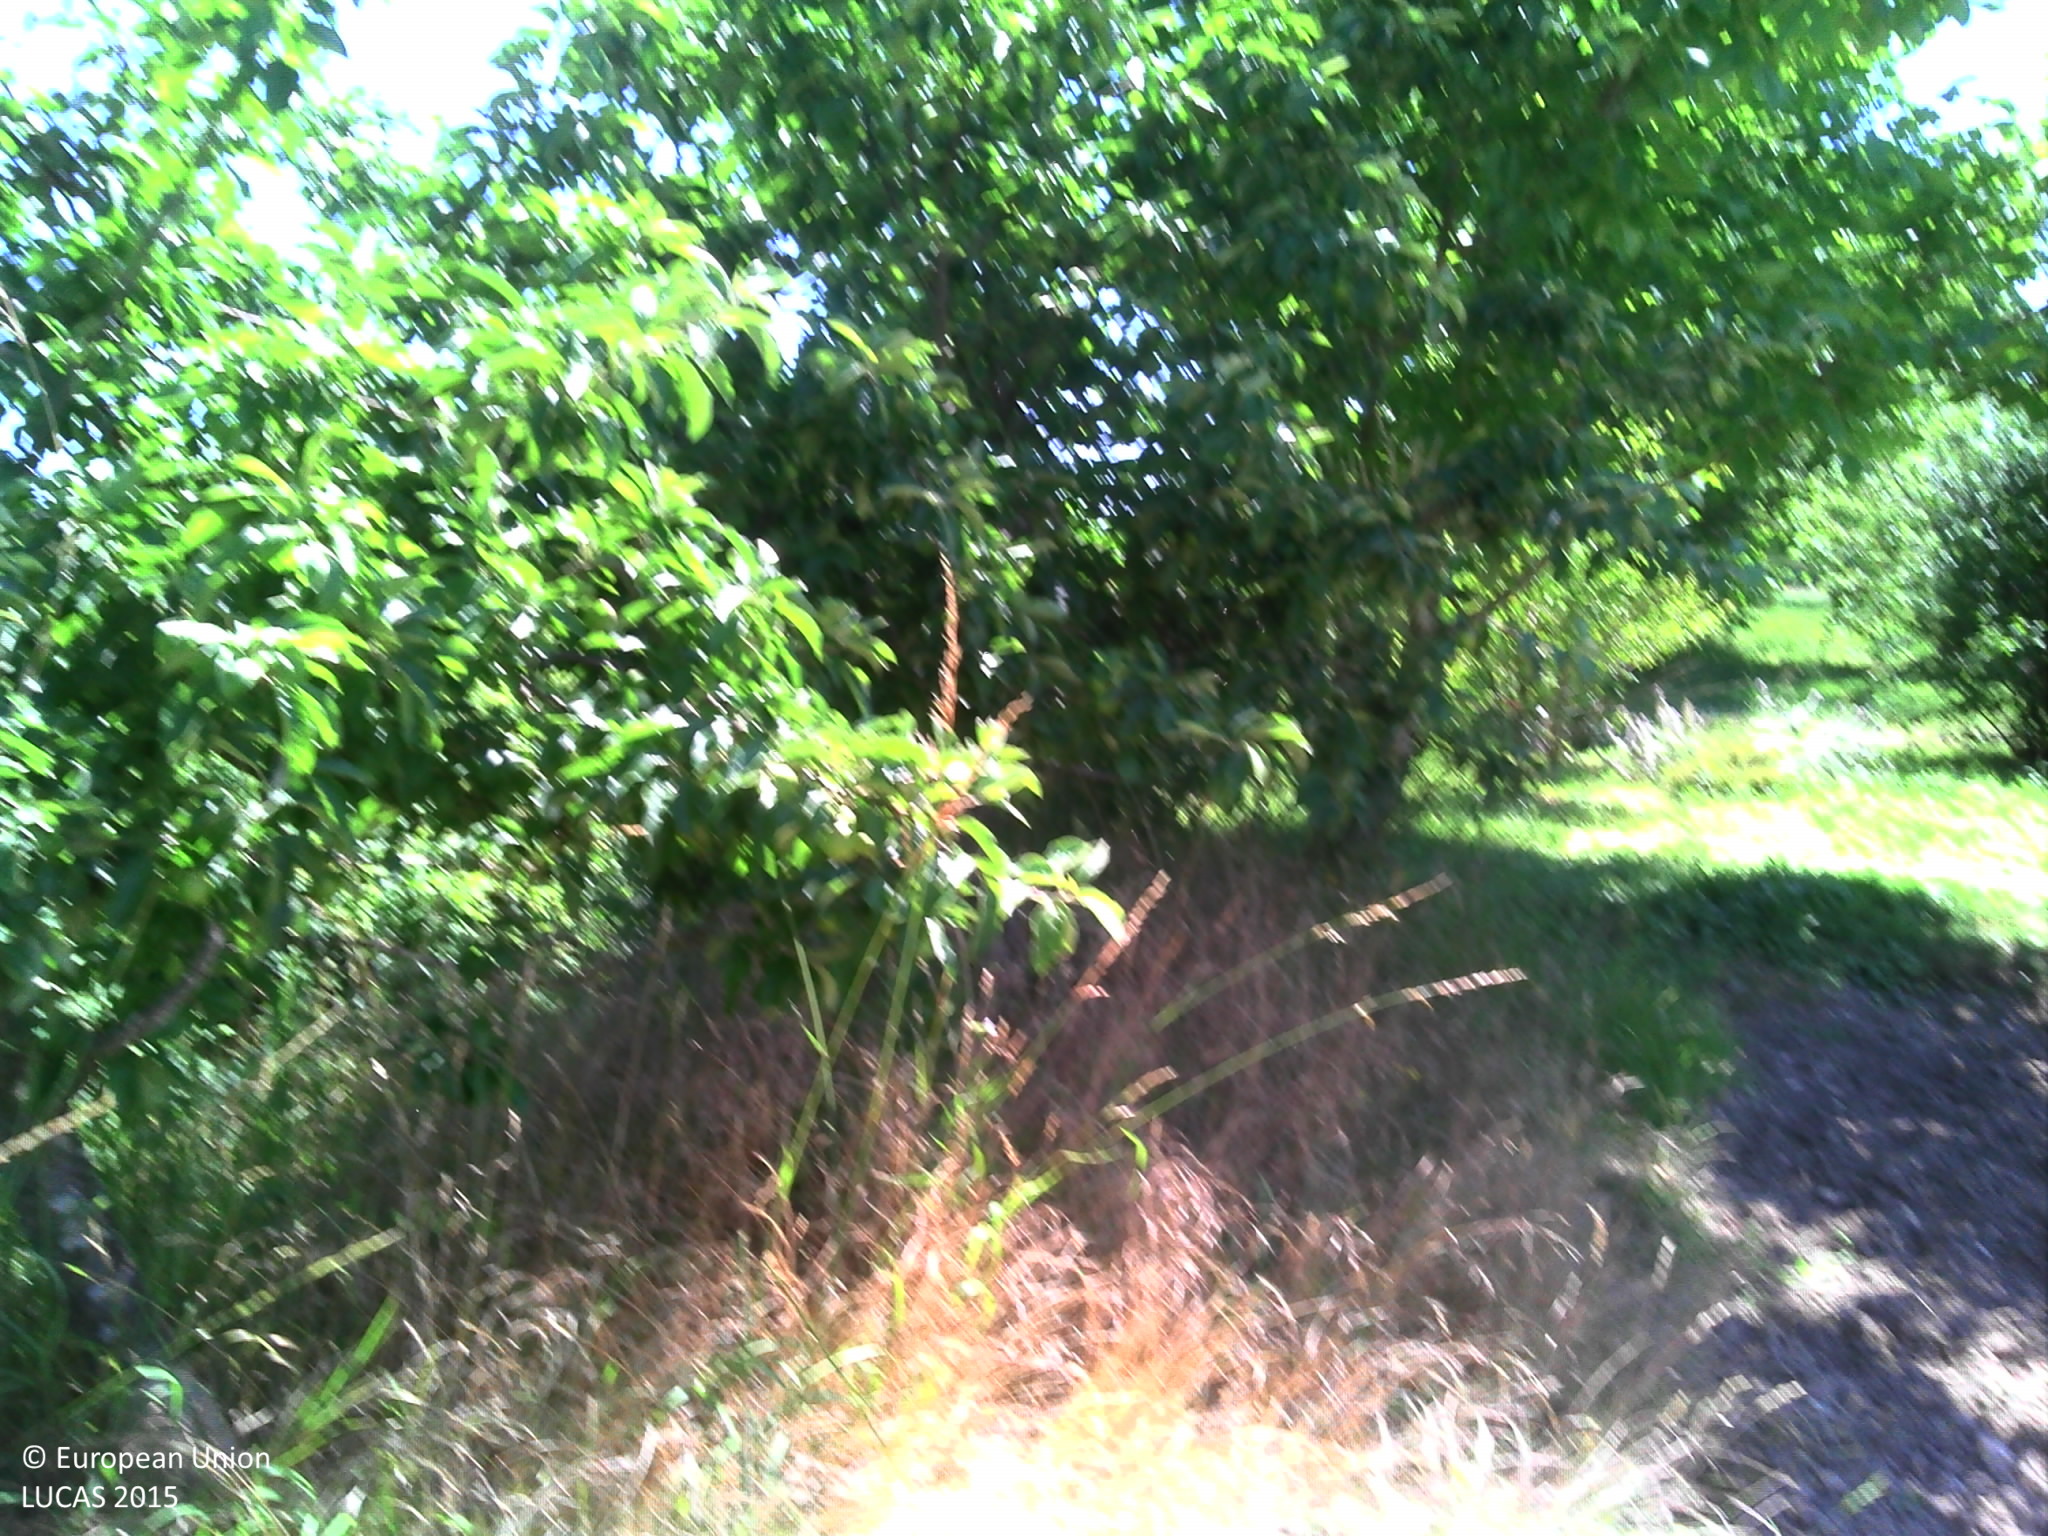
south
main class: Cropland
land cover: Other fresh vegetables
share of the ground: > 75 %
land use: Kitchen garden
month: June
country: FR
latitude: 47.1270
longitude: 2.6247
